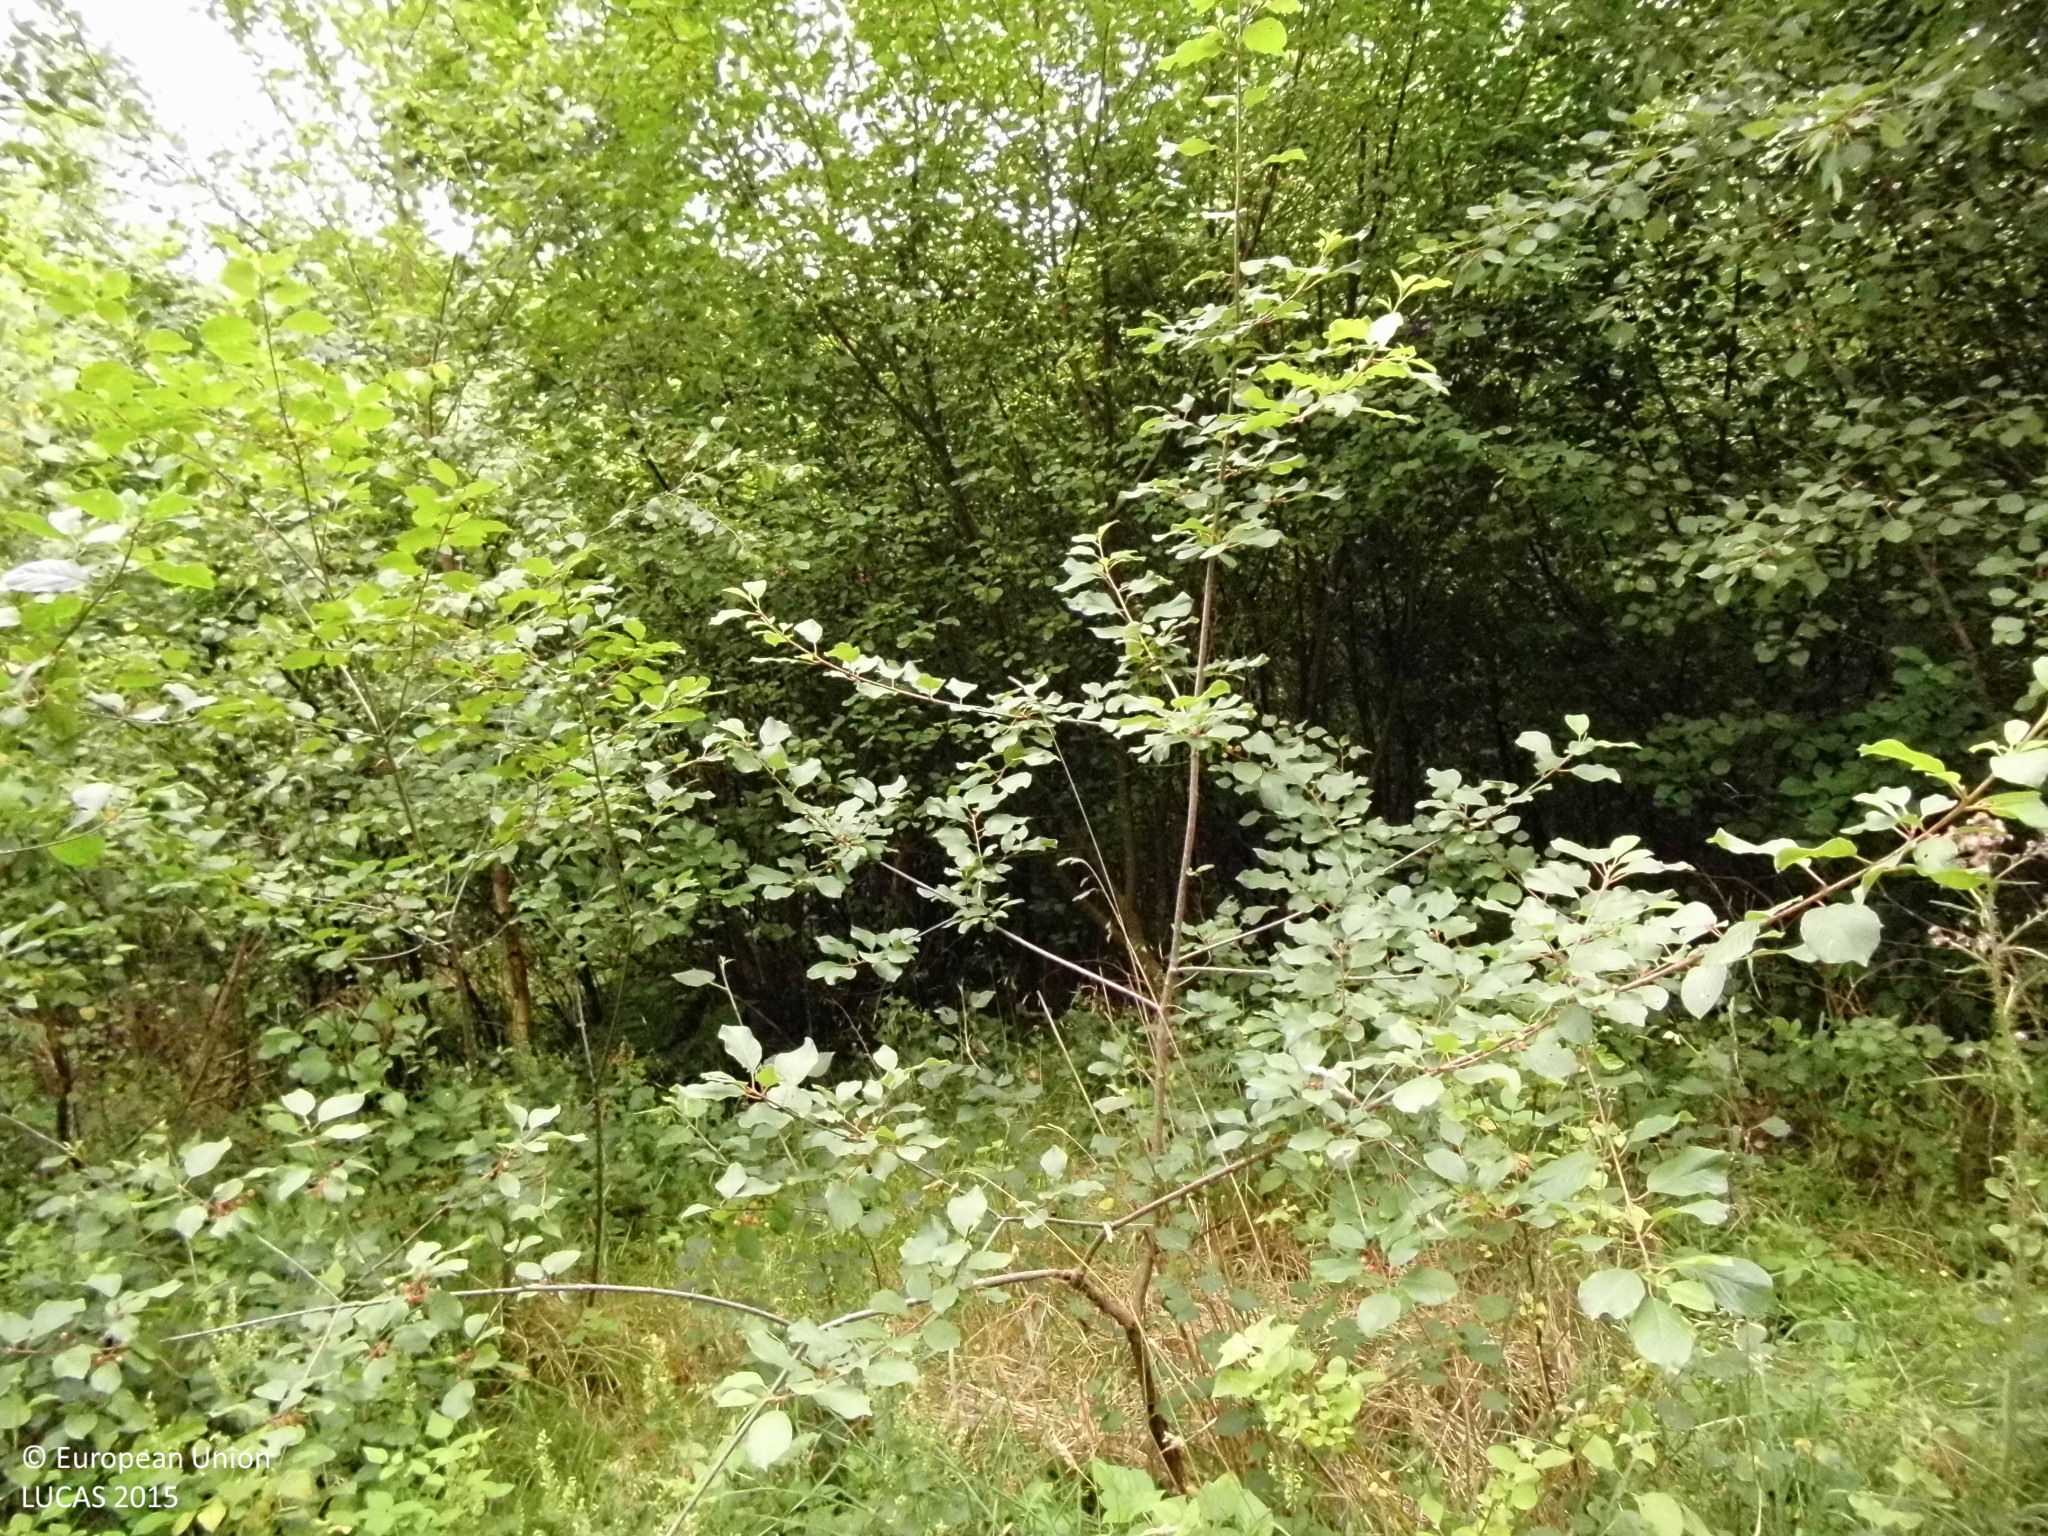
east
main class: Woodland
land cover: Broadleaved woodland
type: mesophytic deciduous forest
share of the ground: > 75 %
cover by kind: broadleaved forest trees 100 %
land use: Forestry
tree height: > 5 m
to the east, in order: Broadleaved woodland; Paved roads, cycling and walking lanes; Broadleaved woodland; Tracks; Lines of trees; Grassland without tree/shrub cover; Rivers and streams; Grassland without tree/shrub cover; Groves; Rivers and streams; Broadleaved woodland; Grassland without tree/shrub cover; Shrubland with sparse tree cover
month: August
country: DE
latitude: 50.9599
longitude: 8.1068
